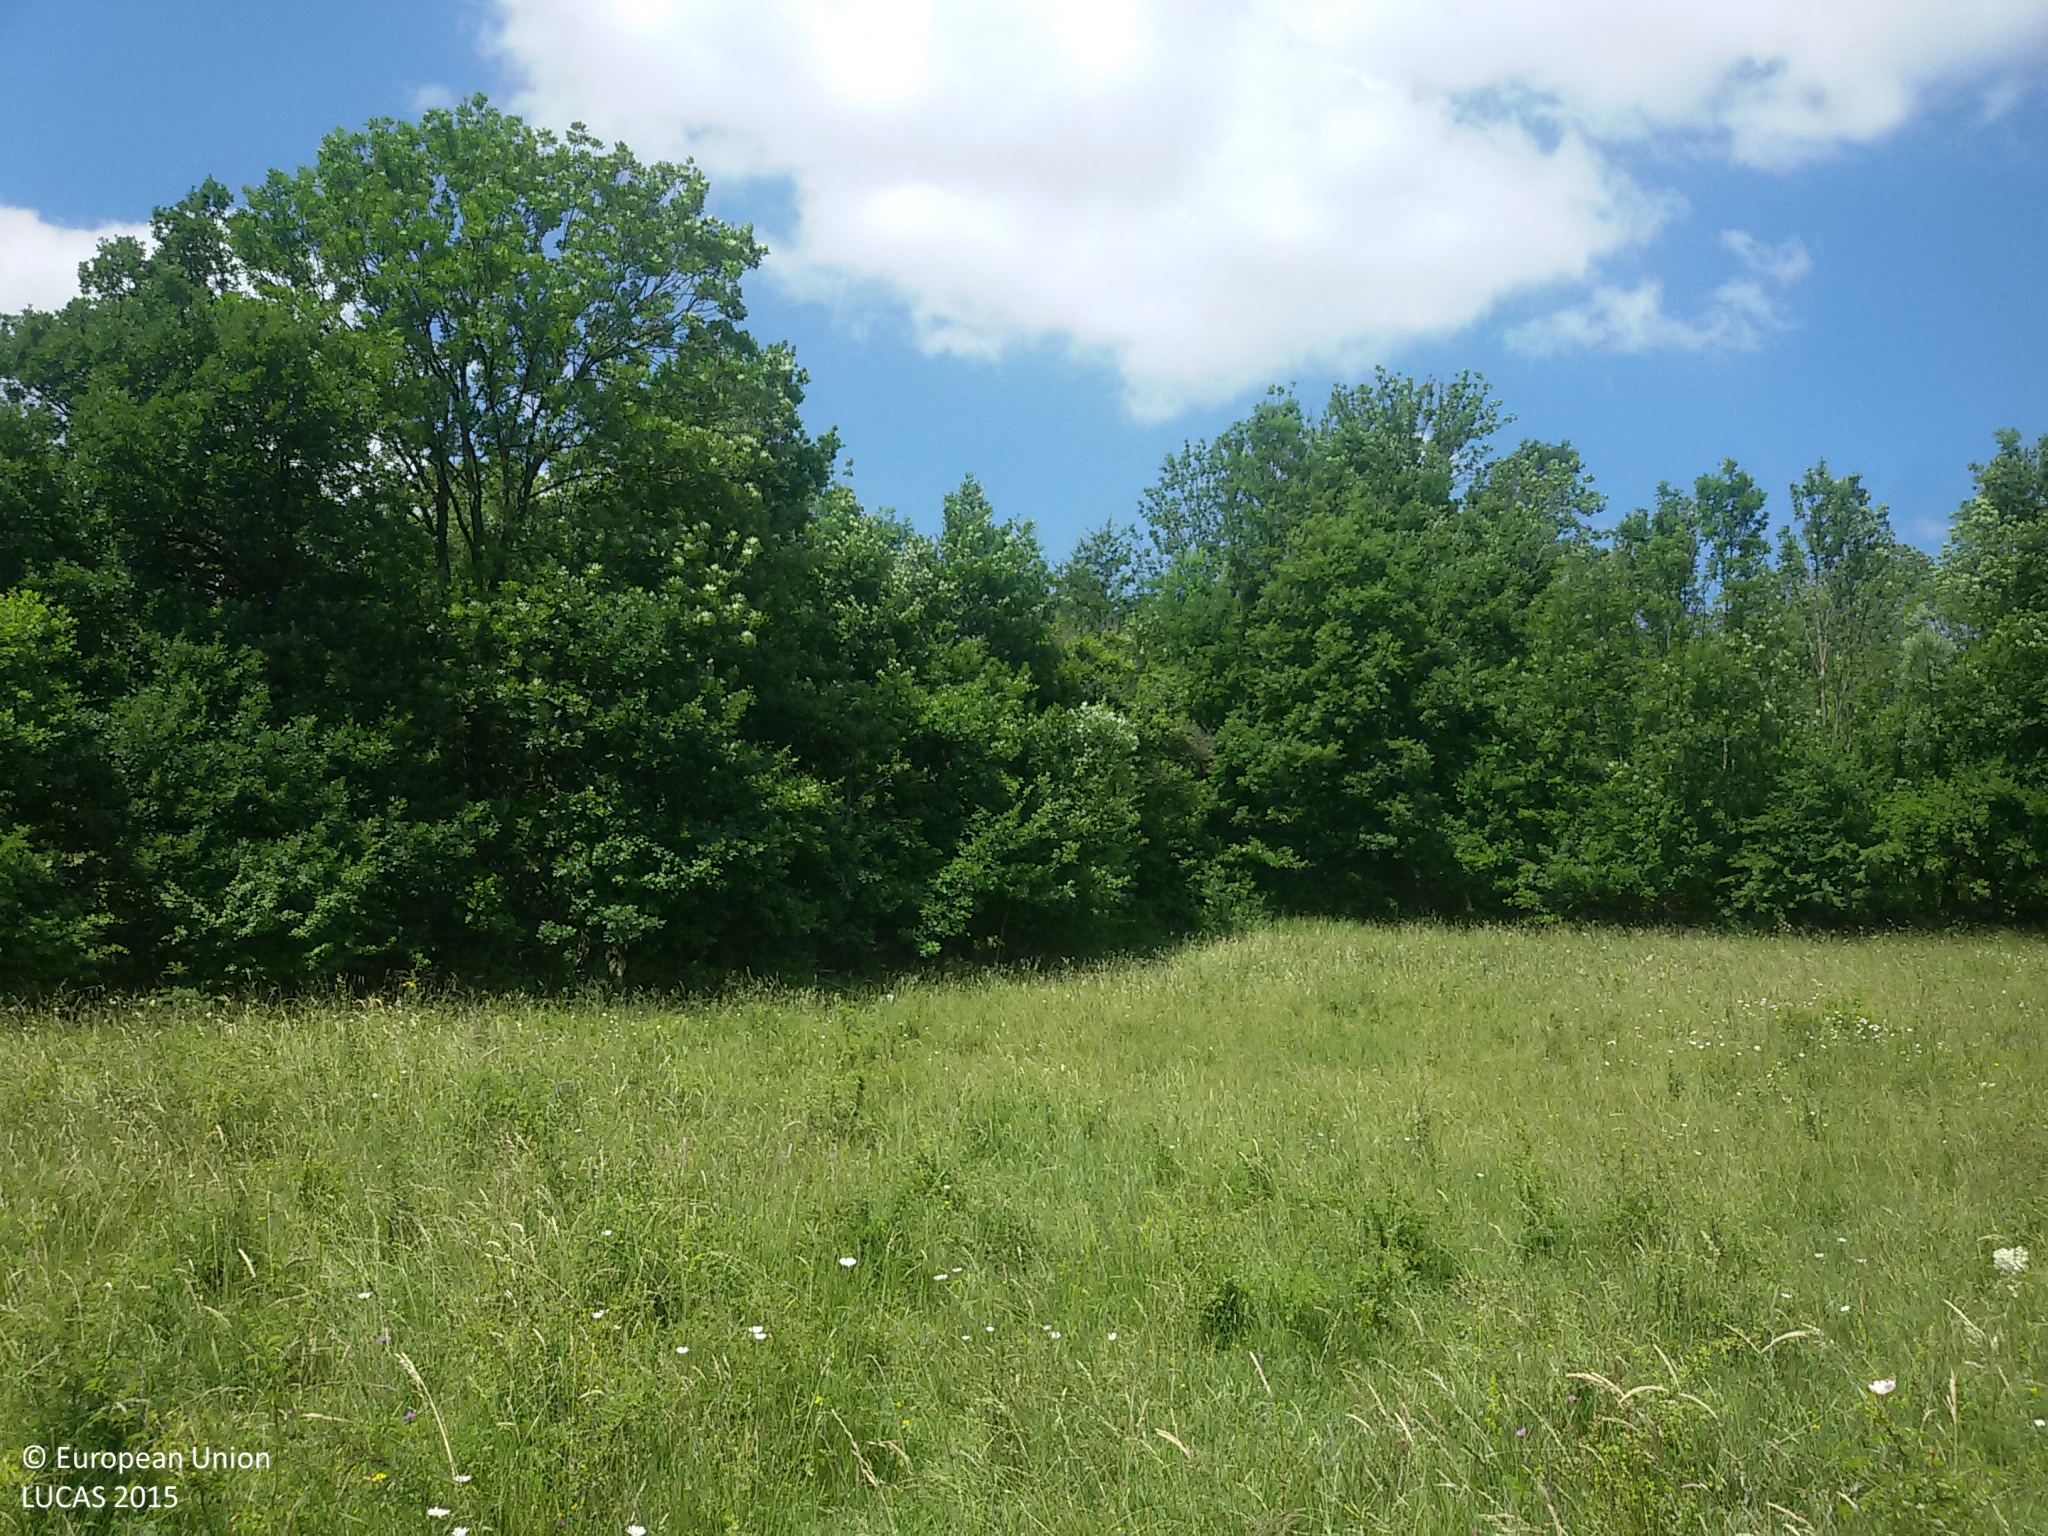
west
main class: Grassland
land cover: Grassland without tree/shrub cover
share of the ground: > 75 %
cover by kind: herbaceous plants 90 %, shrubs 5 %, unconsolidated bare surface 5 %
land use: Agriculture (excluding fallow land and kitchen gardens)
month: June
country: HR
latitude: 44.5155
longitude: 15.7680
